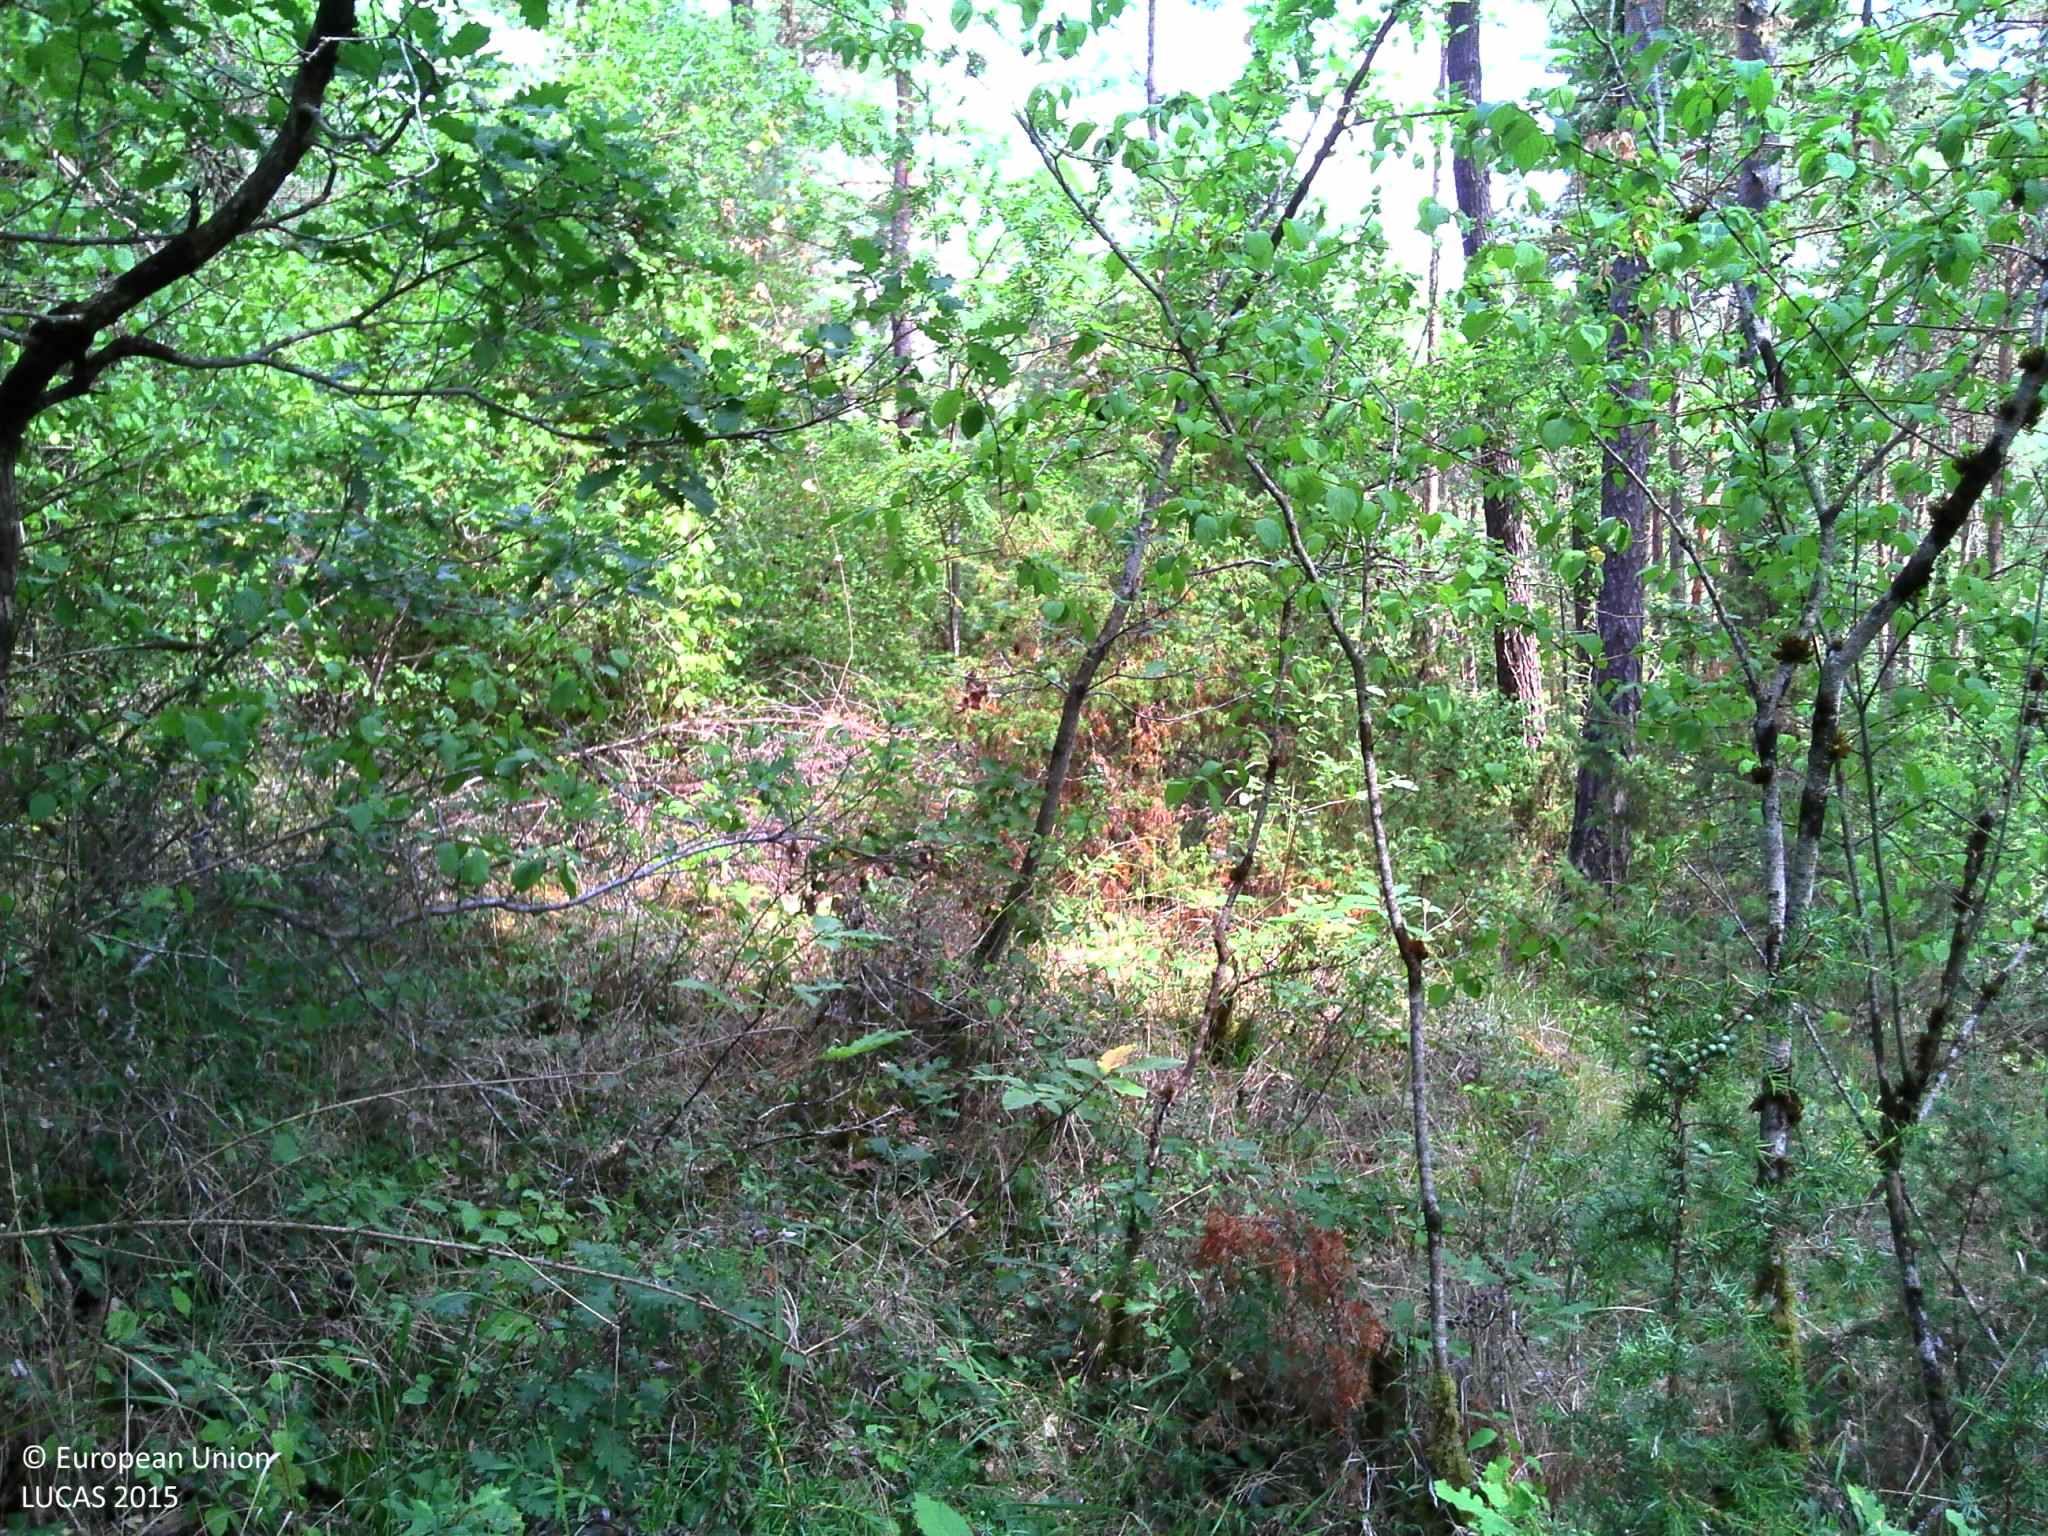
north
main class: Woodland
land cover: Pine dominated mixed woodland
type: hemiboreal forest and nemoral coniferous forest and mixed broadleaved-coniferous forest
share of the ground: > 75 %
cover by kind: broadleaved forest trees 50 %, coniferous forest trees 20 %, herbaceous plants 15 %, lichens and mosses 10 %, shrubs 5 %
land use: Forestry
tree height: > 5 m
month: July
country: FR
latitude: 45.1284
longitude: 1.1057
